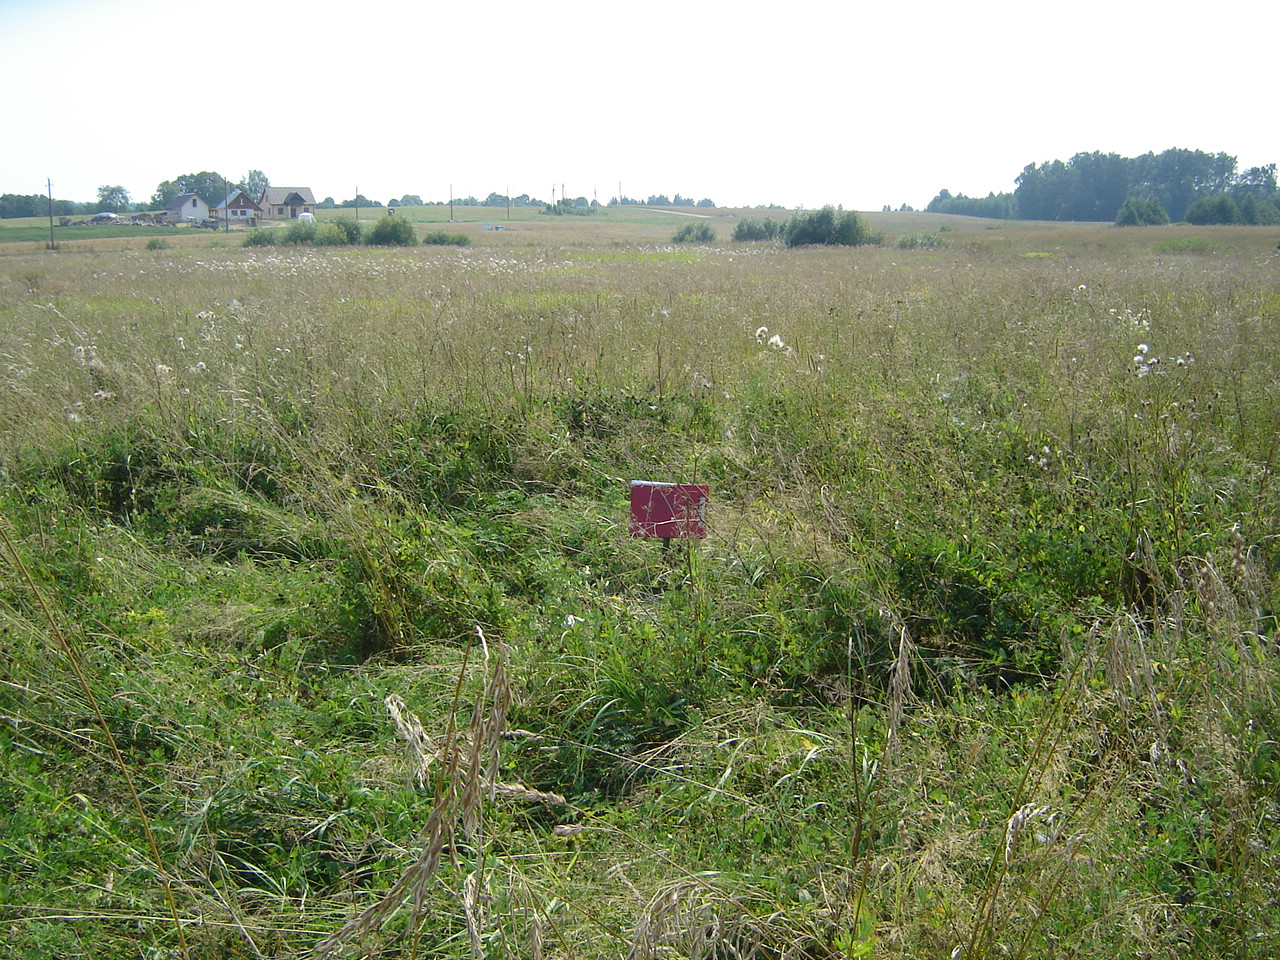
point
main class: Grassland
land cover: Grassland without tree/shrub cover
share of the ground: > 75 %
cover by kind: herbaceous plants 100 %
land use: Agriculture (excluding fallow land and kitchen gardens)
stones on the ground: < 10 %
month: August
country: LT
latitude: 54.8600
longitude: 24.9914
